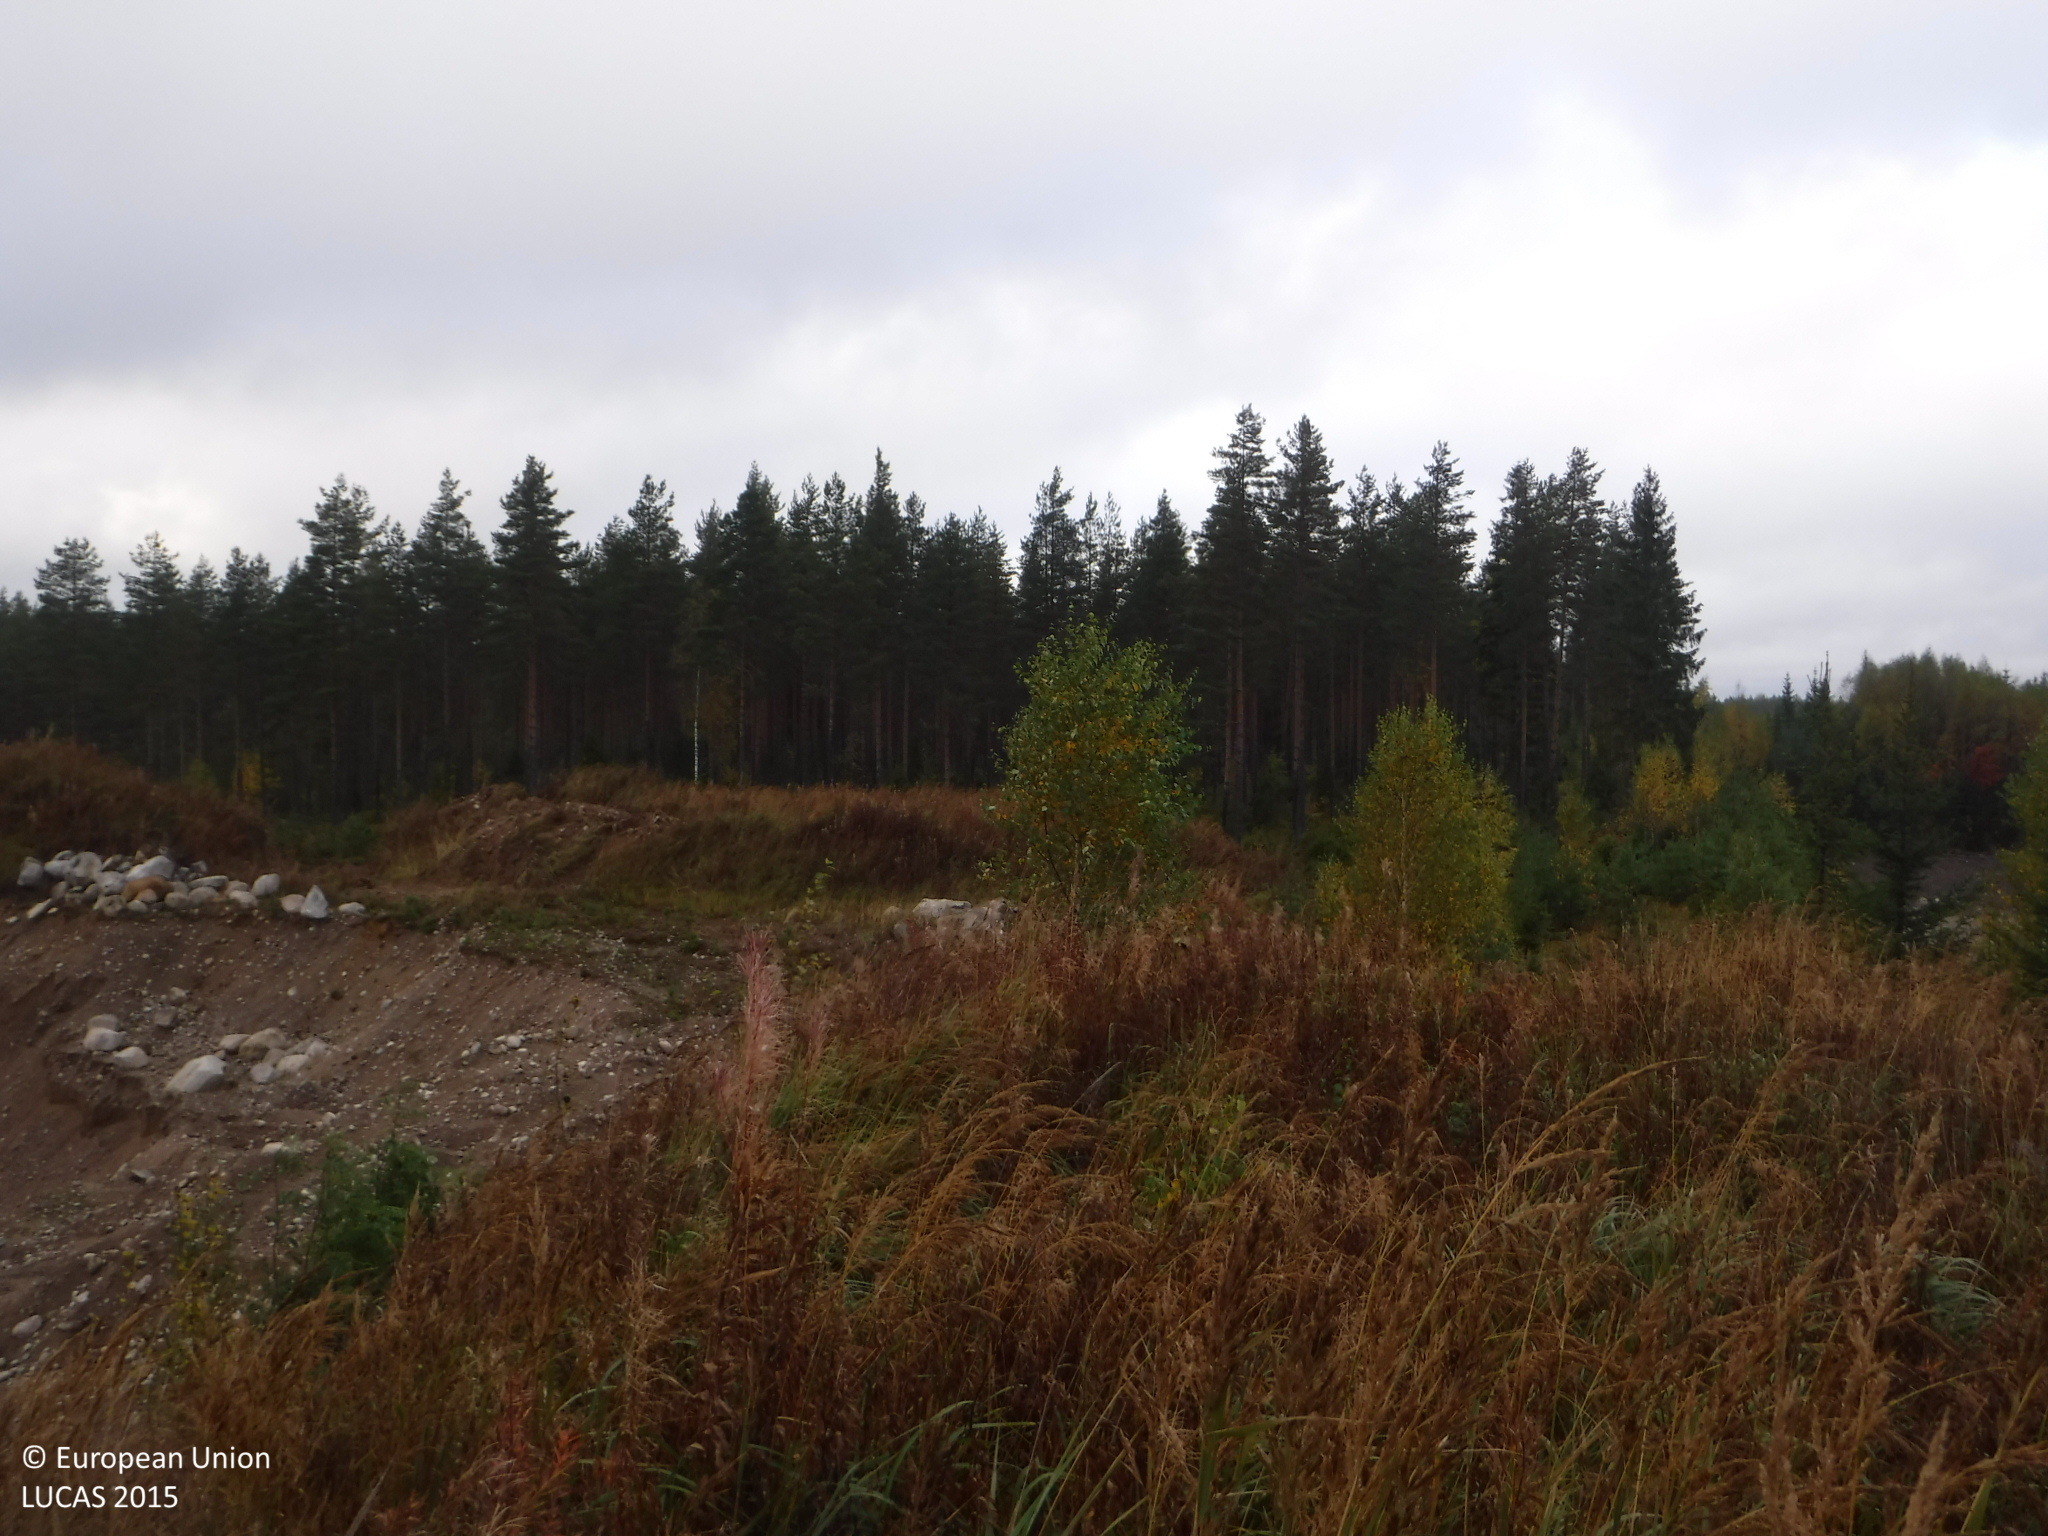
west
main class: Grassland
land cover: Grassland without tree/shrub cover
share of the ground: > 75 %
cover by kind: herbaceous plants 100 %
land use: Mining and quarrying
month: September
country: FI
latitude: 61.8636
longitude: 24.1745
